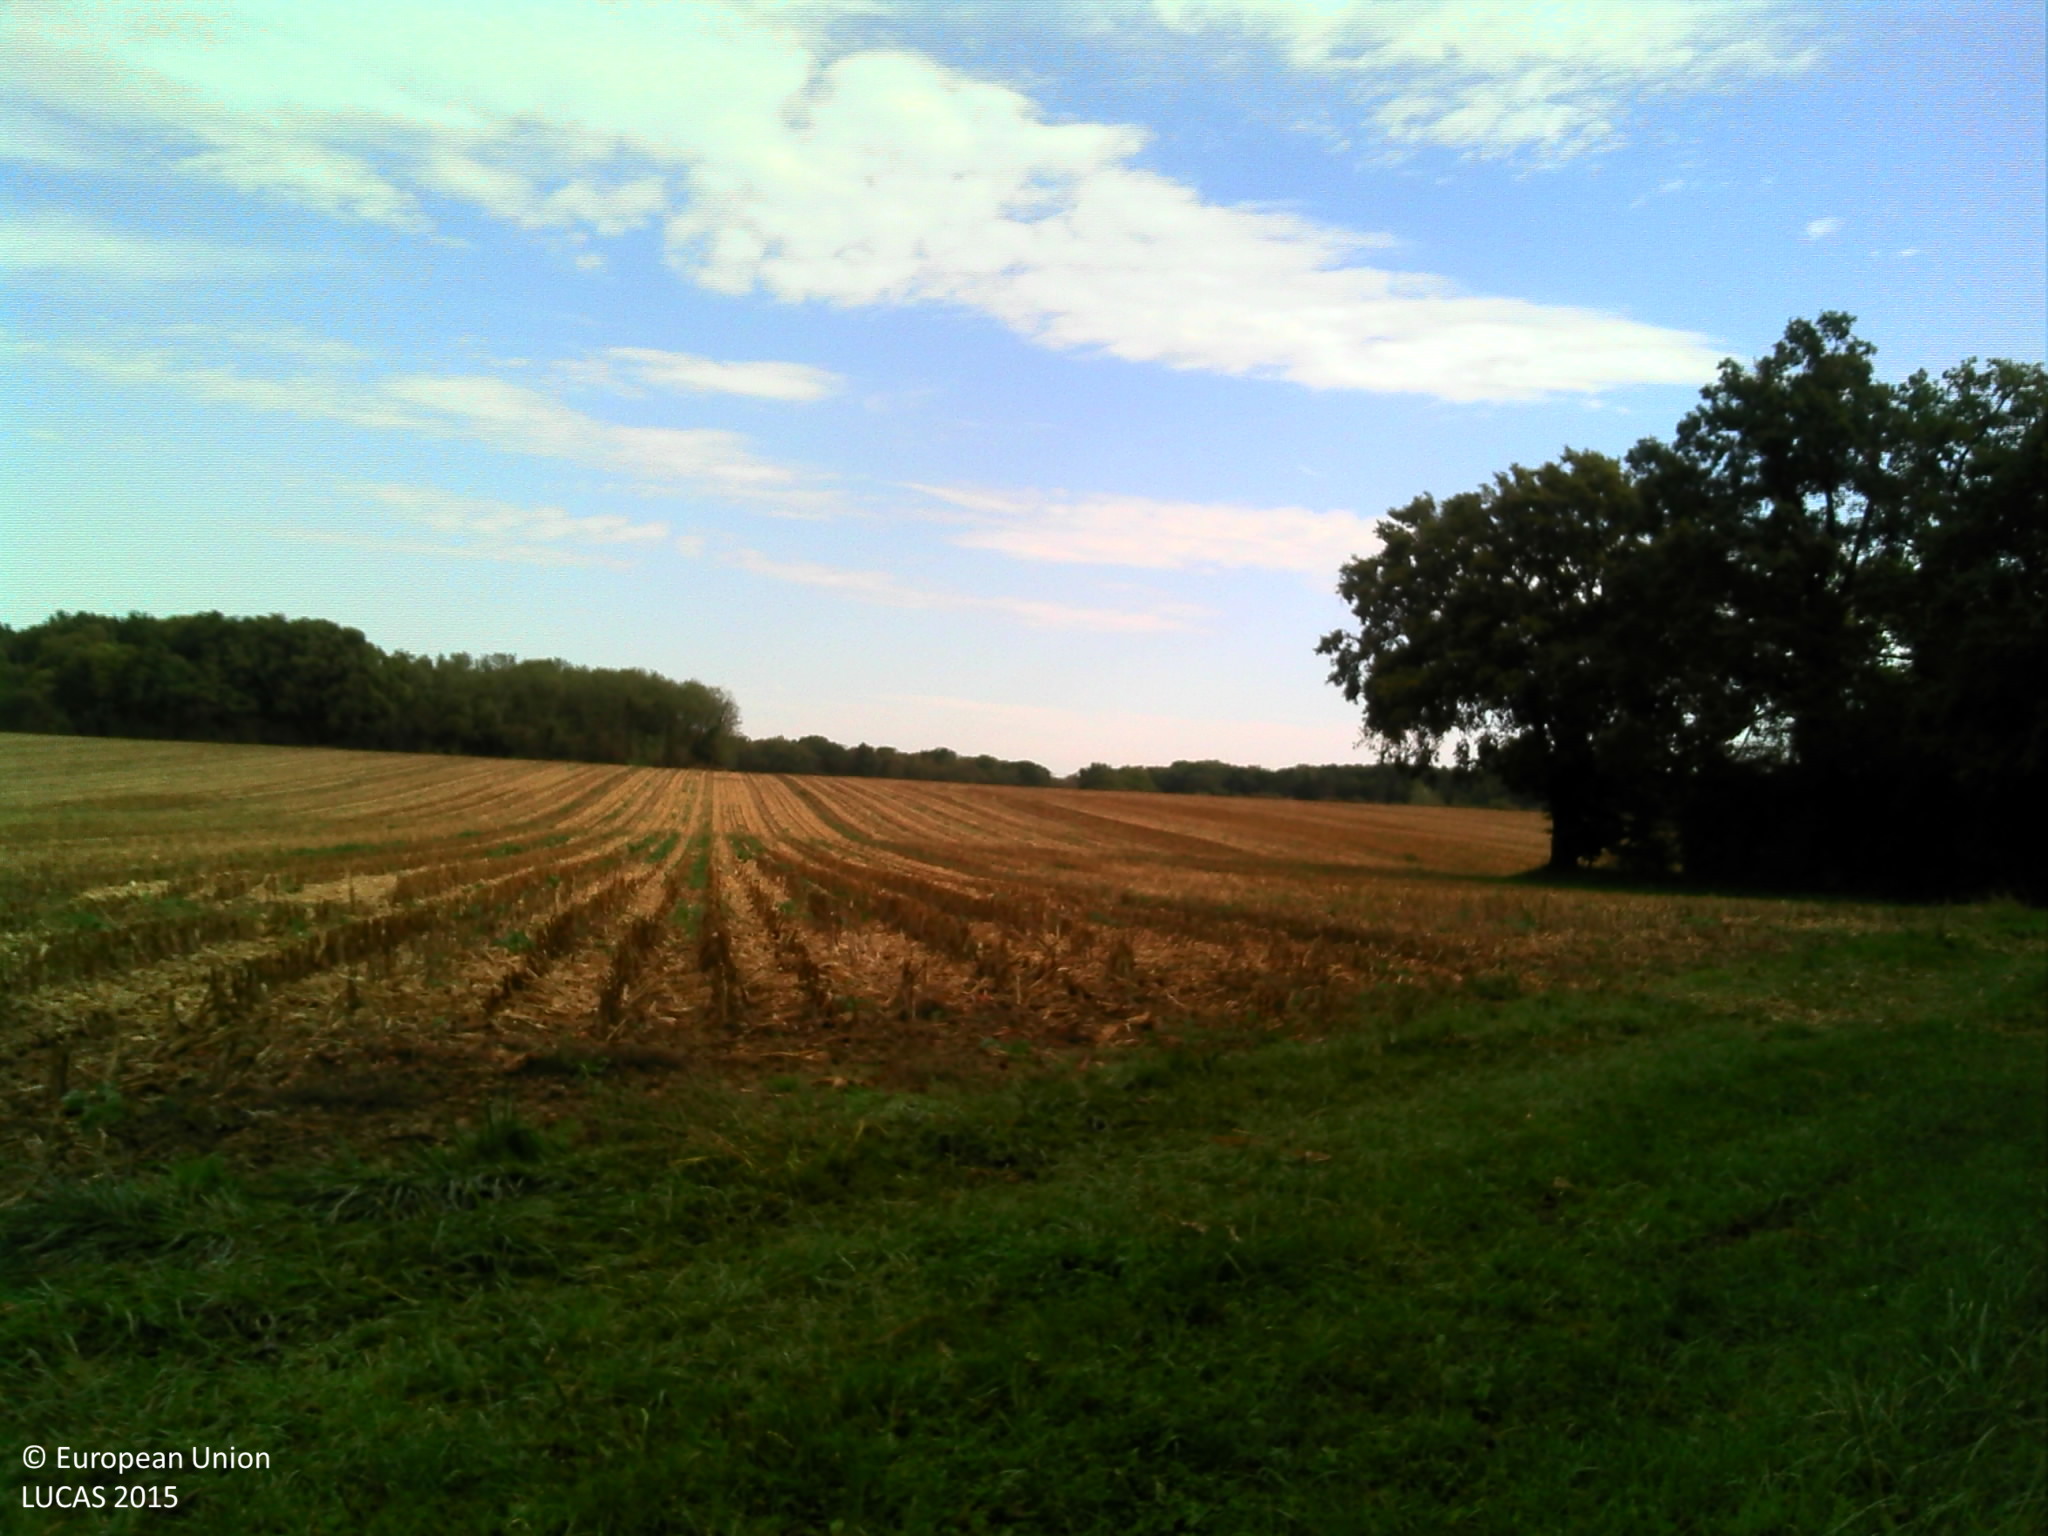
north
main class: Grassland
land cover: Grassland without tree/shrub cover
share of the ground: > 75 %
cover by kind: herbaceous plants 100 %
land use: Agriculture (excluding fallow land and kitchen gardens)
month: October
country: FR
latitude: 45.8730
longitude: 4.9920
